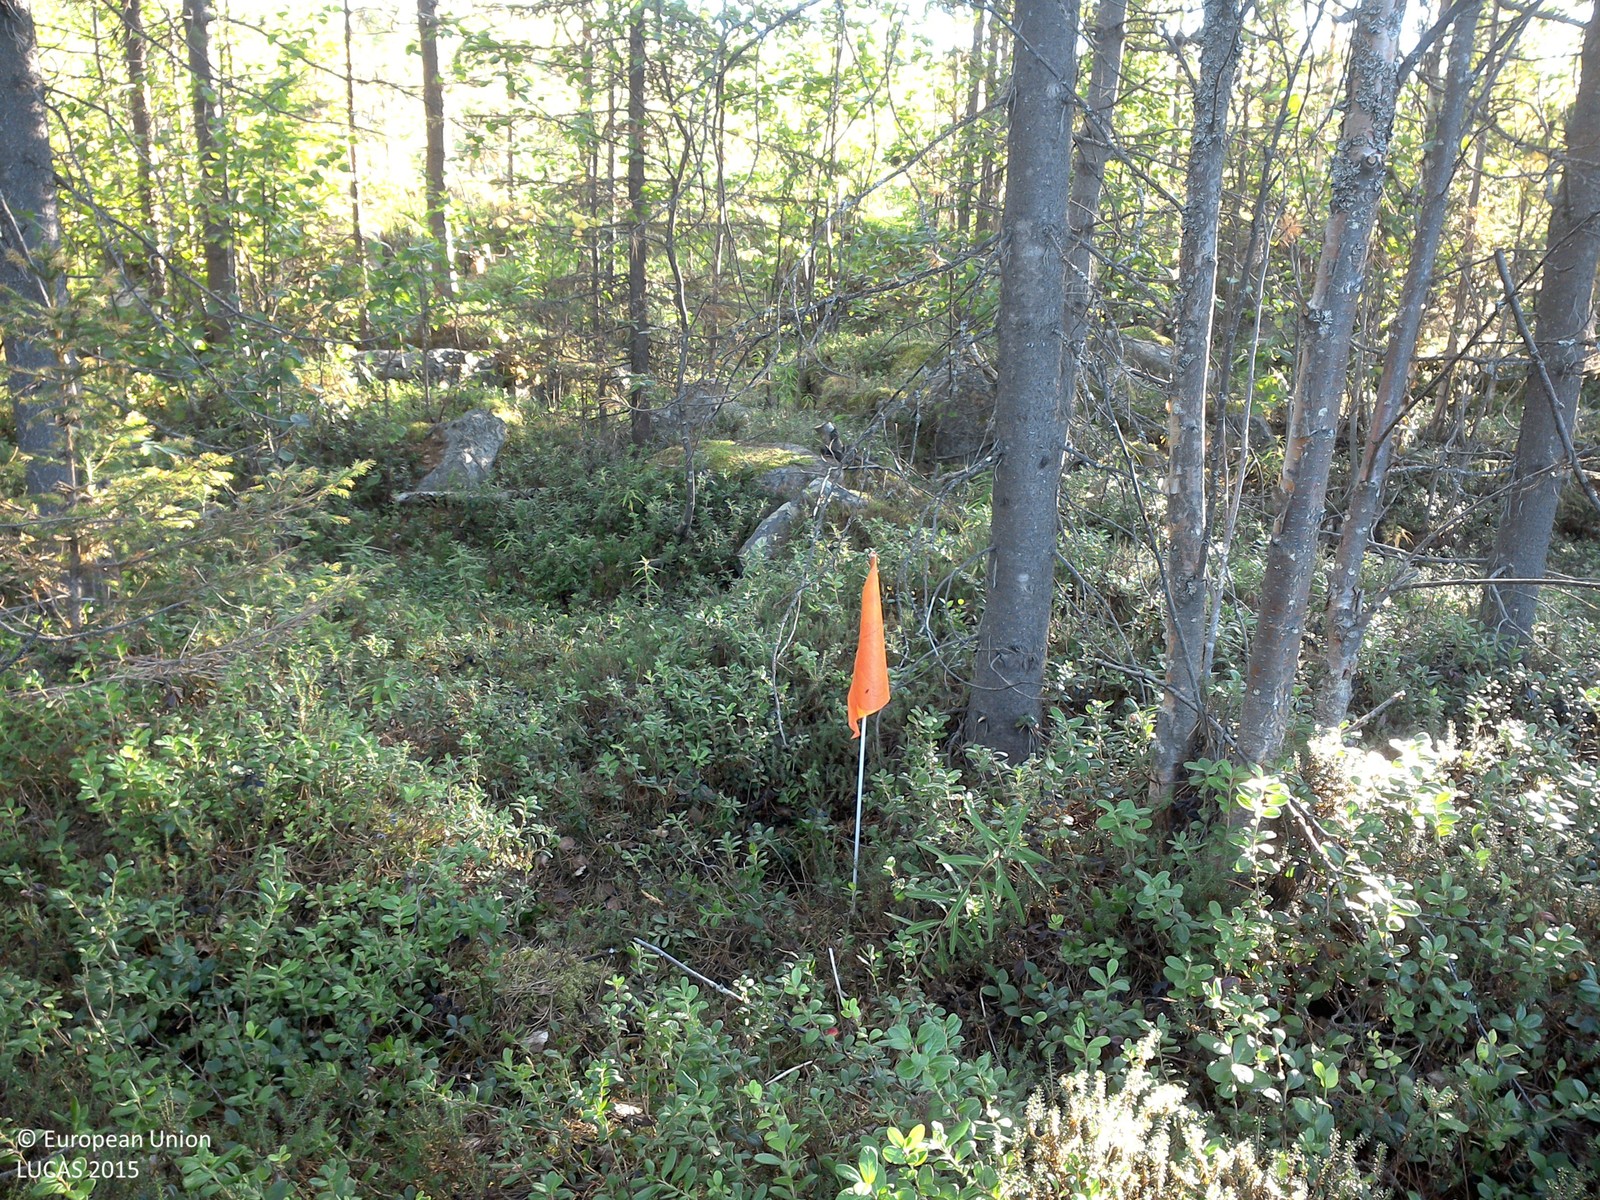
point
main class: Woodland
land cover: Pine dominated coniferous woodland
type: exotic forest
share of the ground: 50 - 75 %
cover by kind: coniferous forest trees 45 %, shrubs 45 %, broadleaved forest trees 5 %, lichens and mosses 5 %
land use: Forestry
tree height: > 5 m
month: August
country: SE
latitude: 67.0635
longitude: 21.6608
